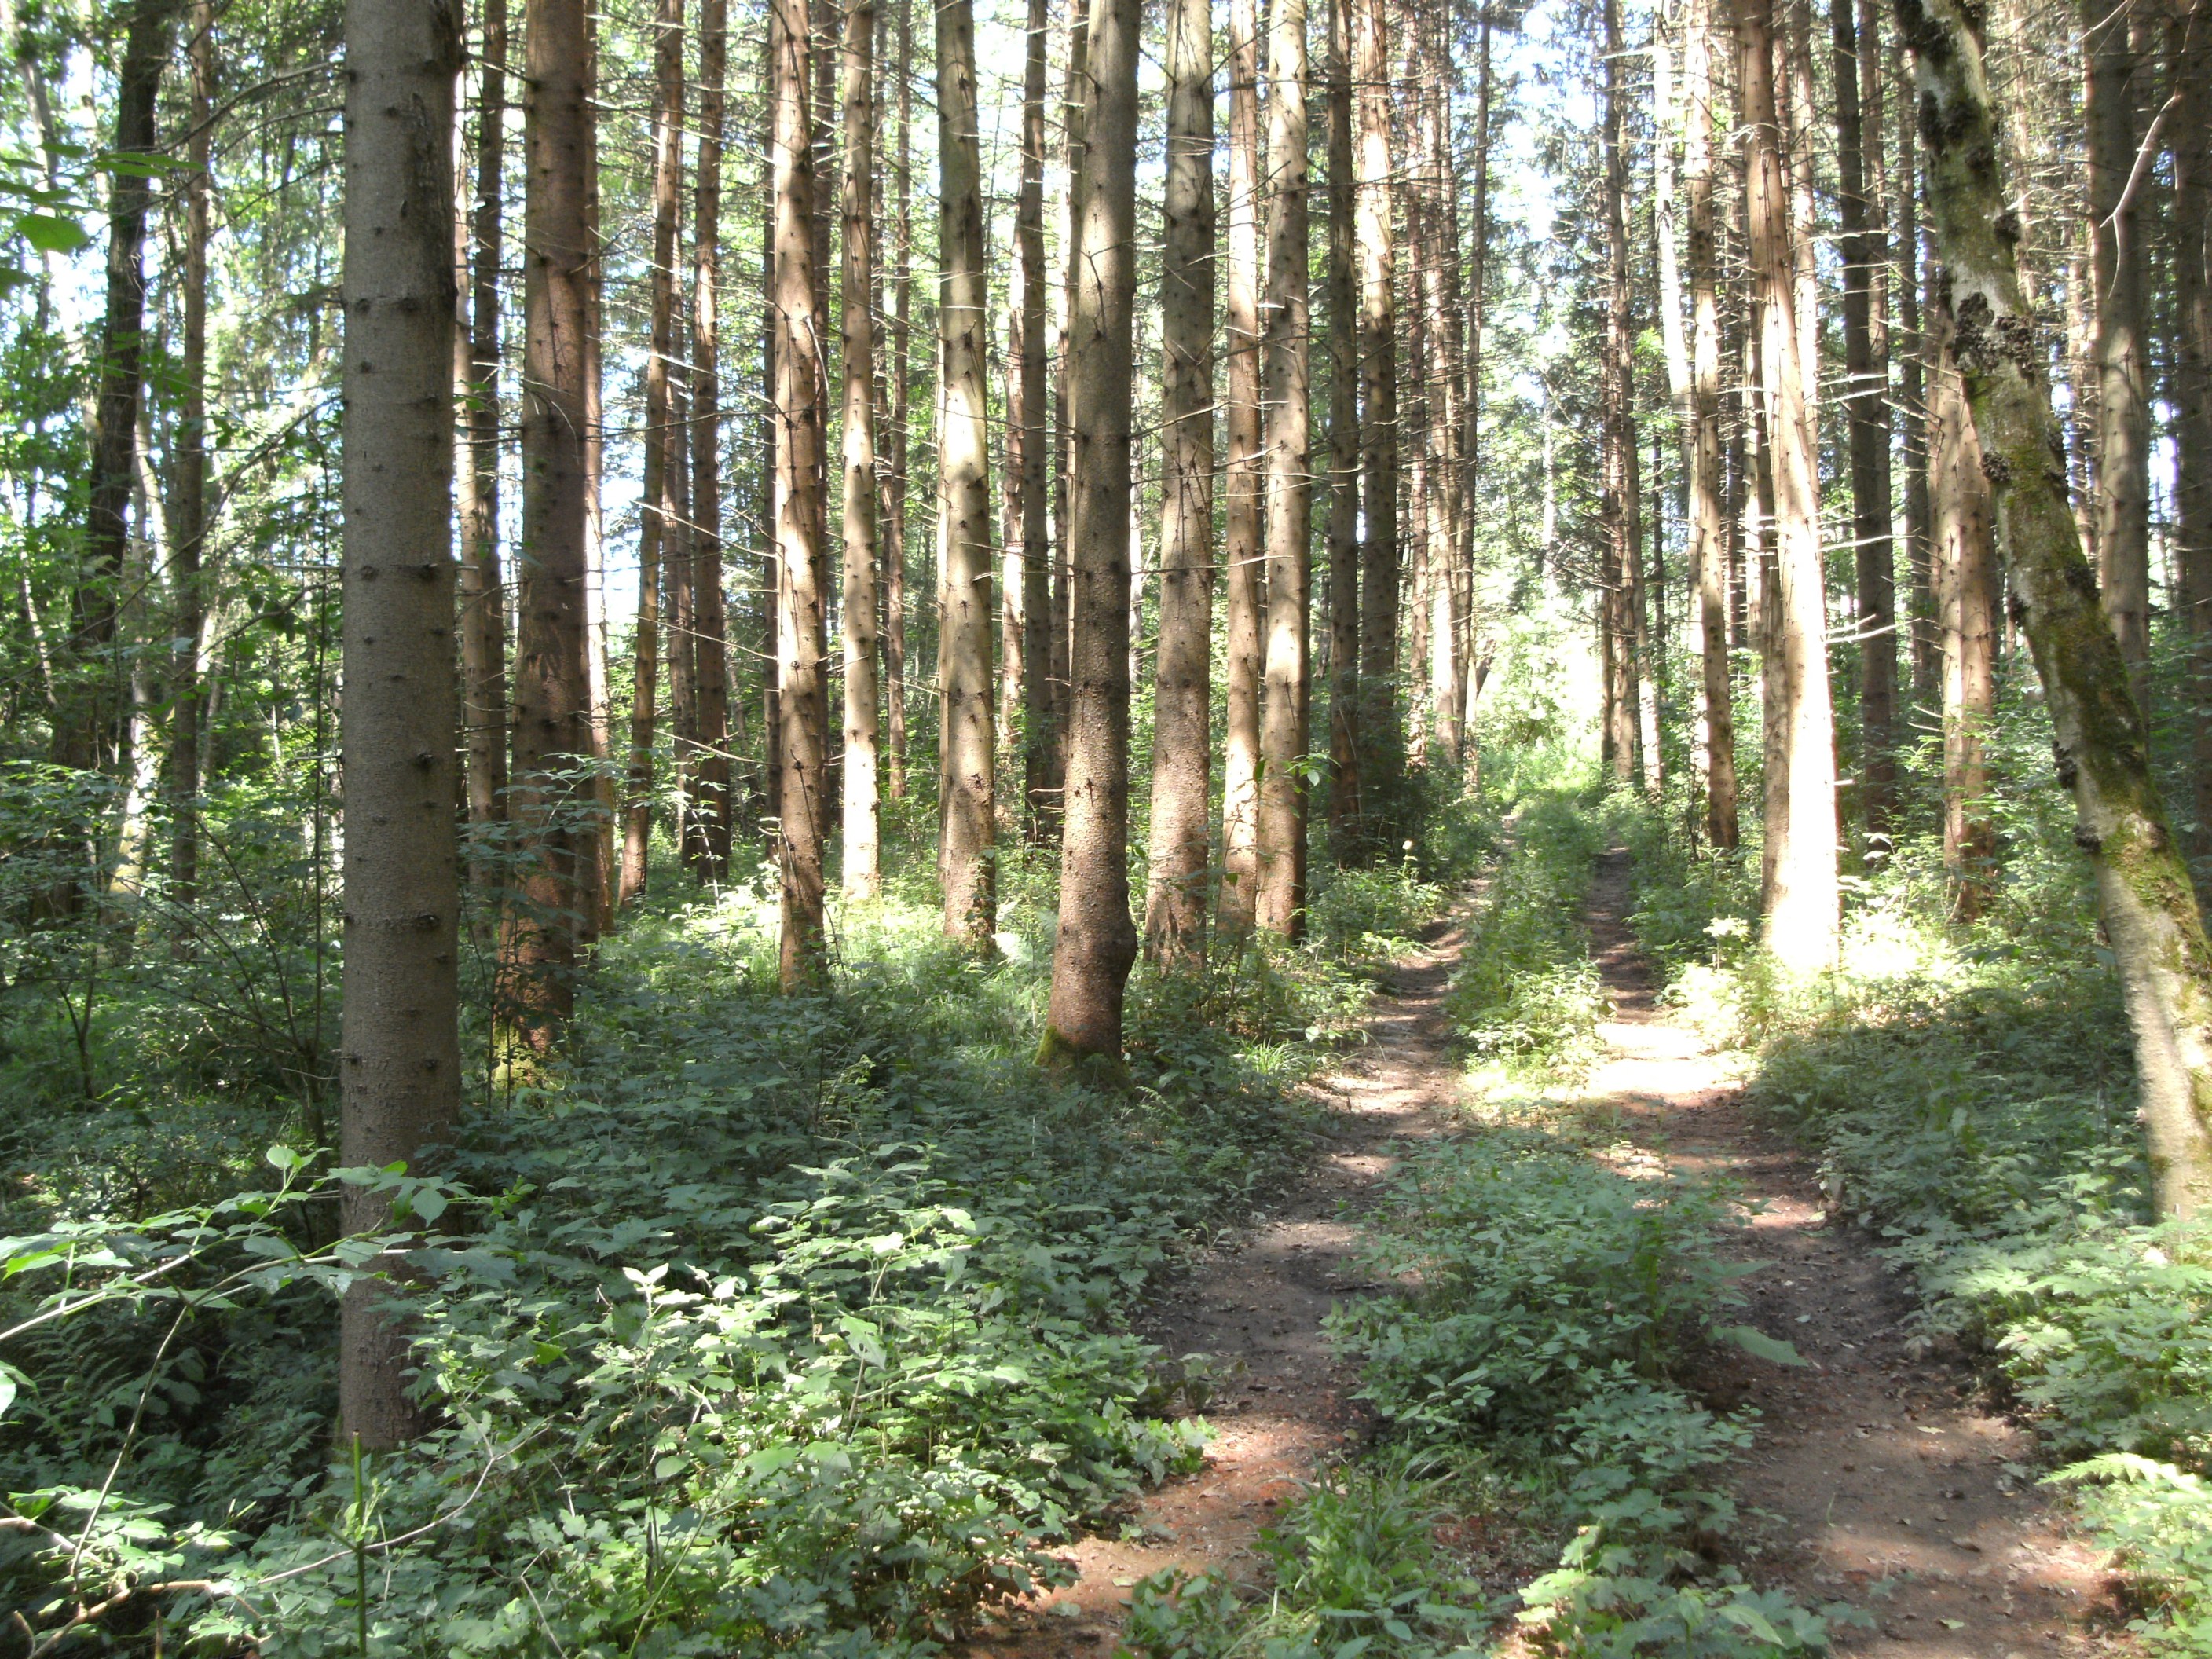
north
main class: Woodland
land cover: Spruce dominated mixed woodland
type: mire and swamp forests
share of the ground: > 75 %
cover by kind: coniferous forest trees 40 %, broadleaved forest trees 35 %, shrubs 15 %, herbaceous plants 10 %
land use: Forestry
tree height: > 5 m
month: July
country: AT
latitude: 46.6887
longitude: 14.9277
